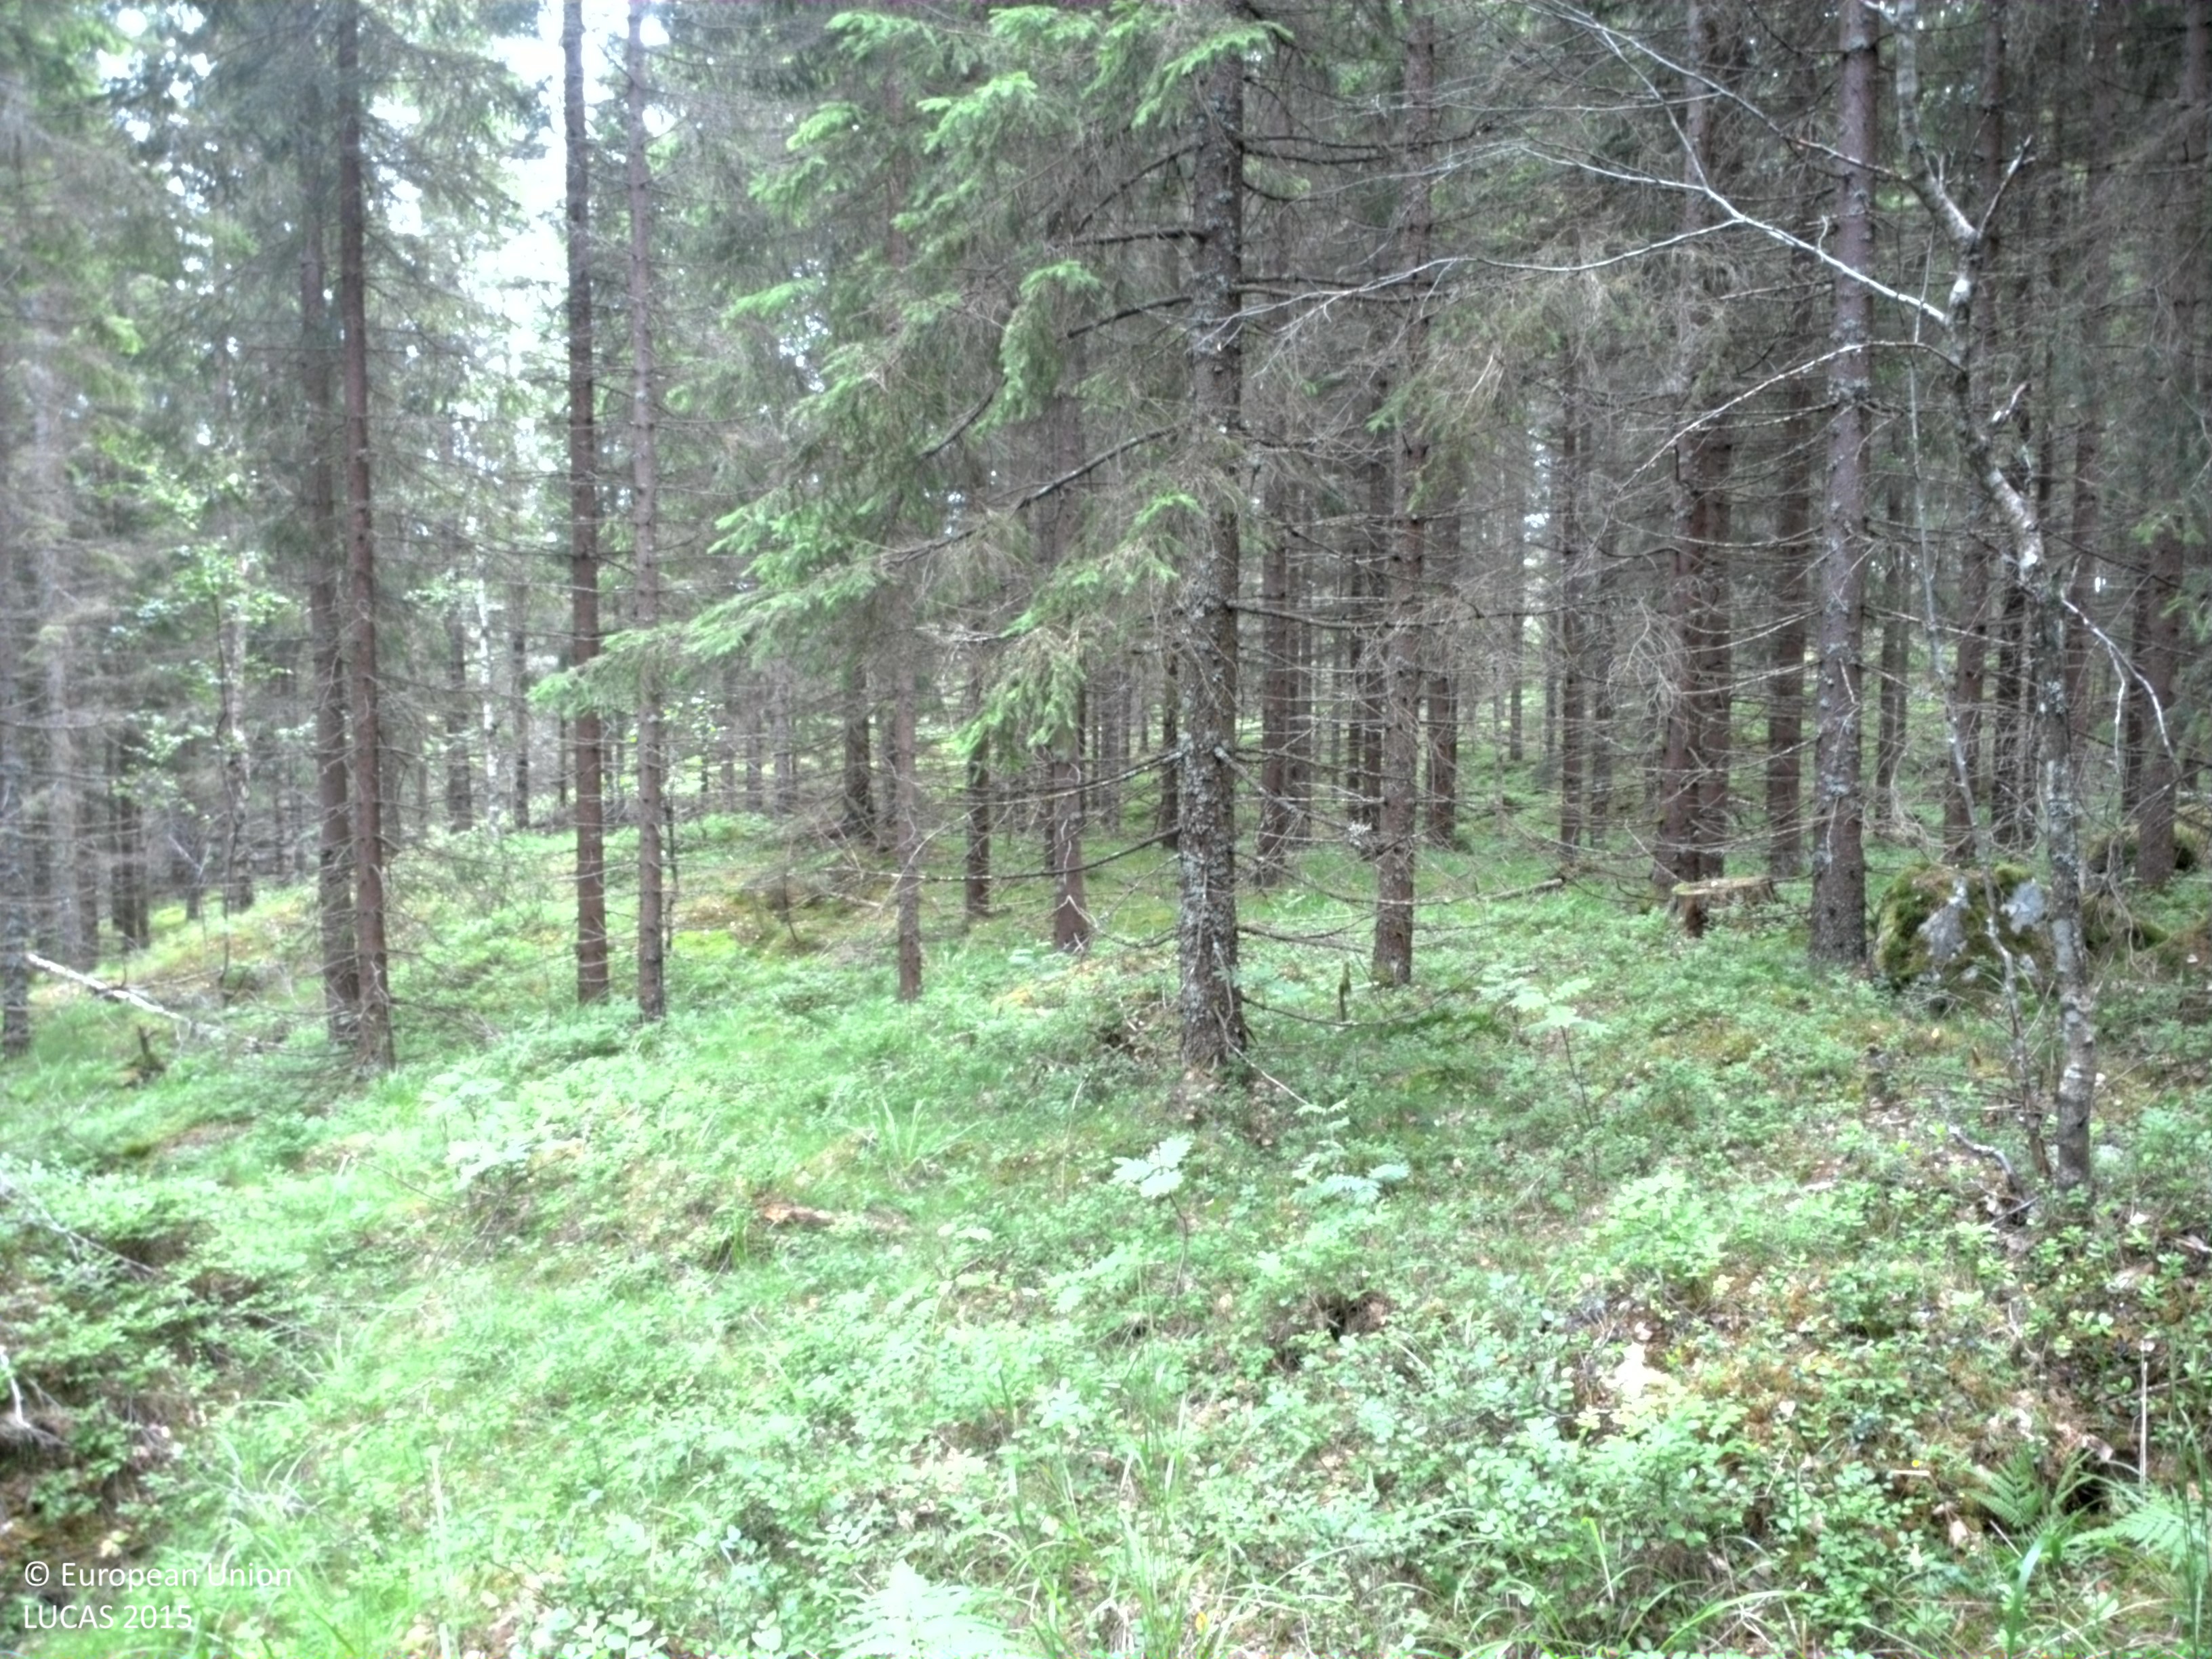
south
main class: Woodland
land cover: Spruce dominated mixed woodland
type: boreal forest
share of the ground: 25 - 50 %
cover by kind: coniferous forest trees 35 %, herbaceous plants 25 %, broadleaved forest trees 15 %, shrubs 15 %, lichens and mosses 10 %
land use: Forestry
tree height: > 5 m
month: July
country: SE
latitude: 59.6093
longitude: 11.9264
